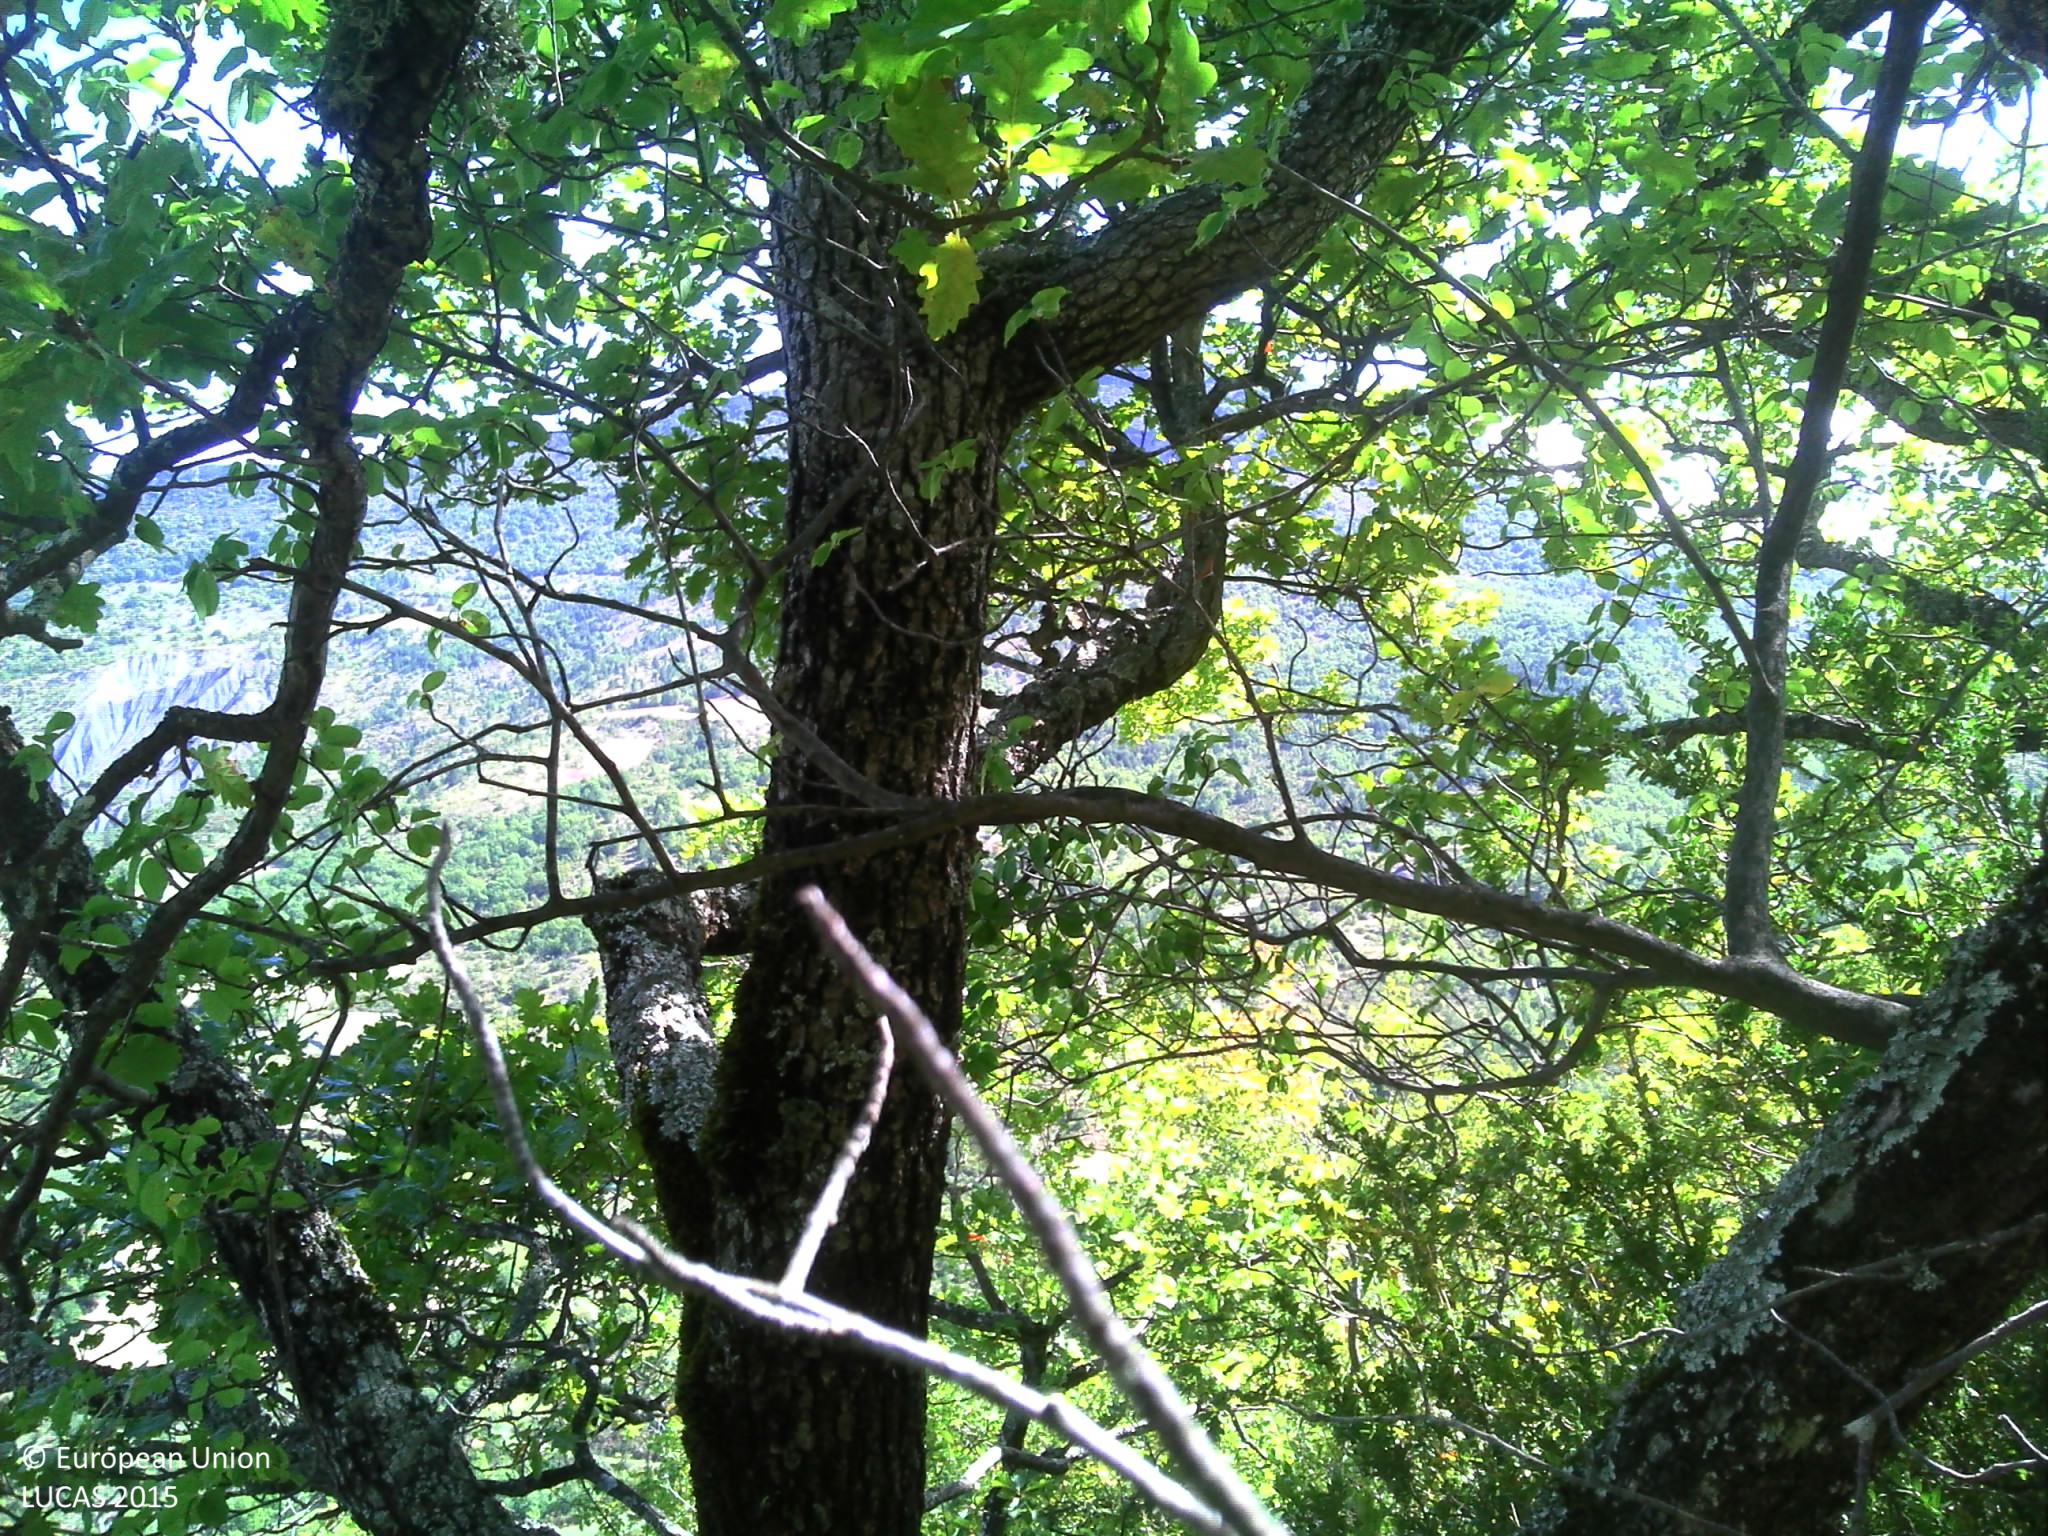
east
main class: Woodland
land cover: Broadleaved woodland
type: thermophilous deciduous forest
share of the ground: > 75 %
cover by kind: broadleaved forest trees 90 %, coniferous forest trees 5 %, herbaceous plants 5 %
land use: Semi-natural and natural areas not in use
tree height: > 5 m
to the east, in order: Broadleaved woodland; Other bare soil; Broadleaved woodland; Rivers and streams; Pine dominated mixed woodland
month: September
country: FR
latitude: 44.2458
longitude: 5.3367
